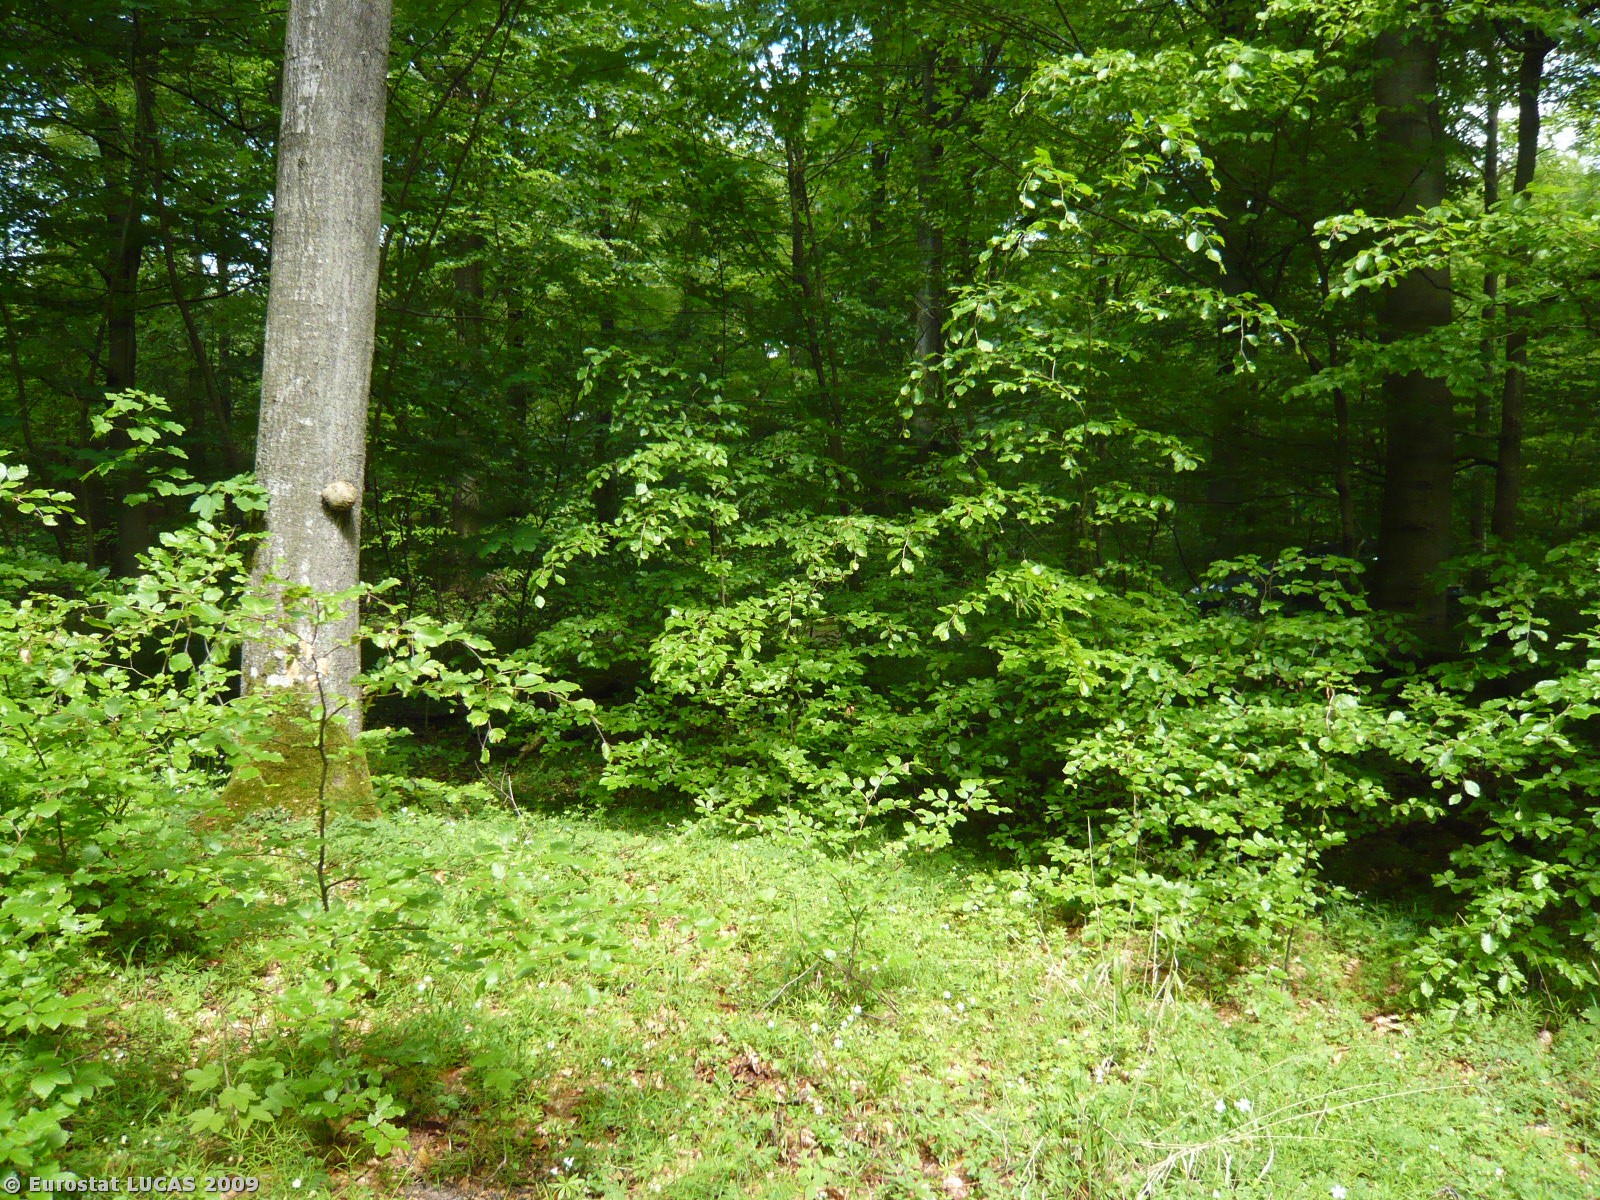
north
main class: Woodland
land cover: Broadleaved woodland
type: mesophytic deciduous forest
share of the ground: > 75 %
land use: Forestry
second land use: Amenities, museums, leisure
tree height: > 5 m
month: May
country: DK
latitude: 55.4228
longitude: 11.5944
